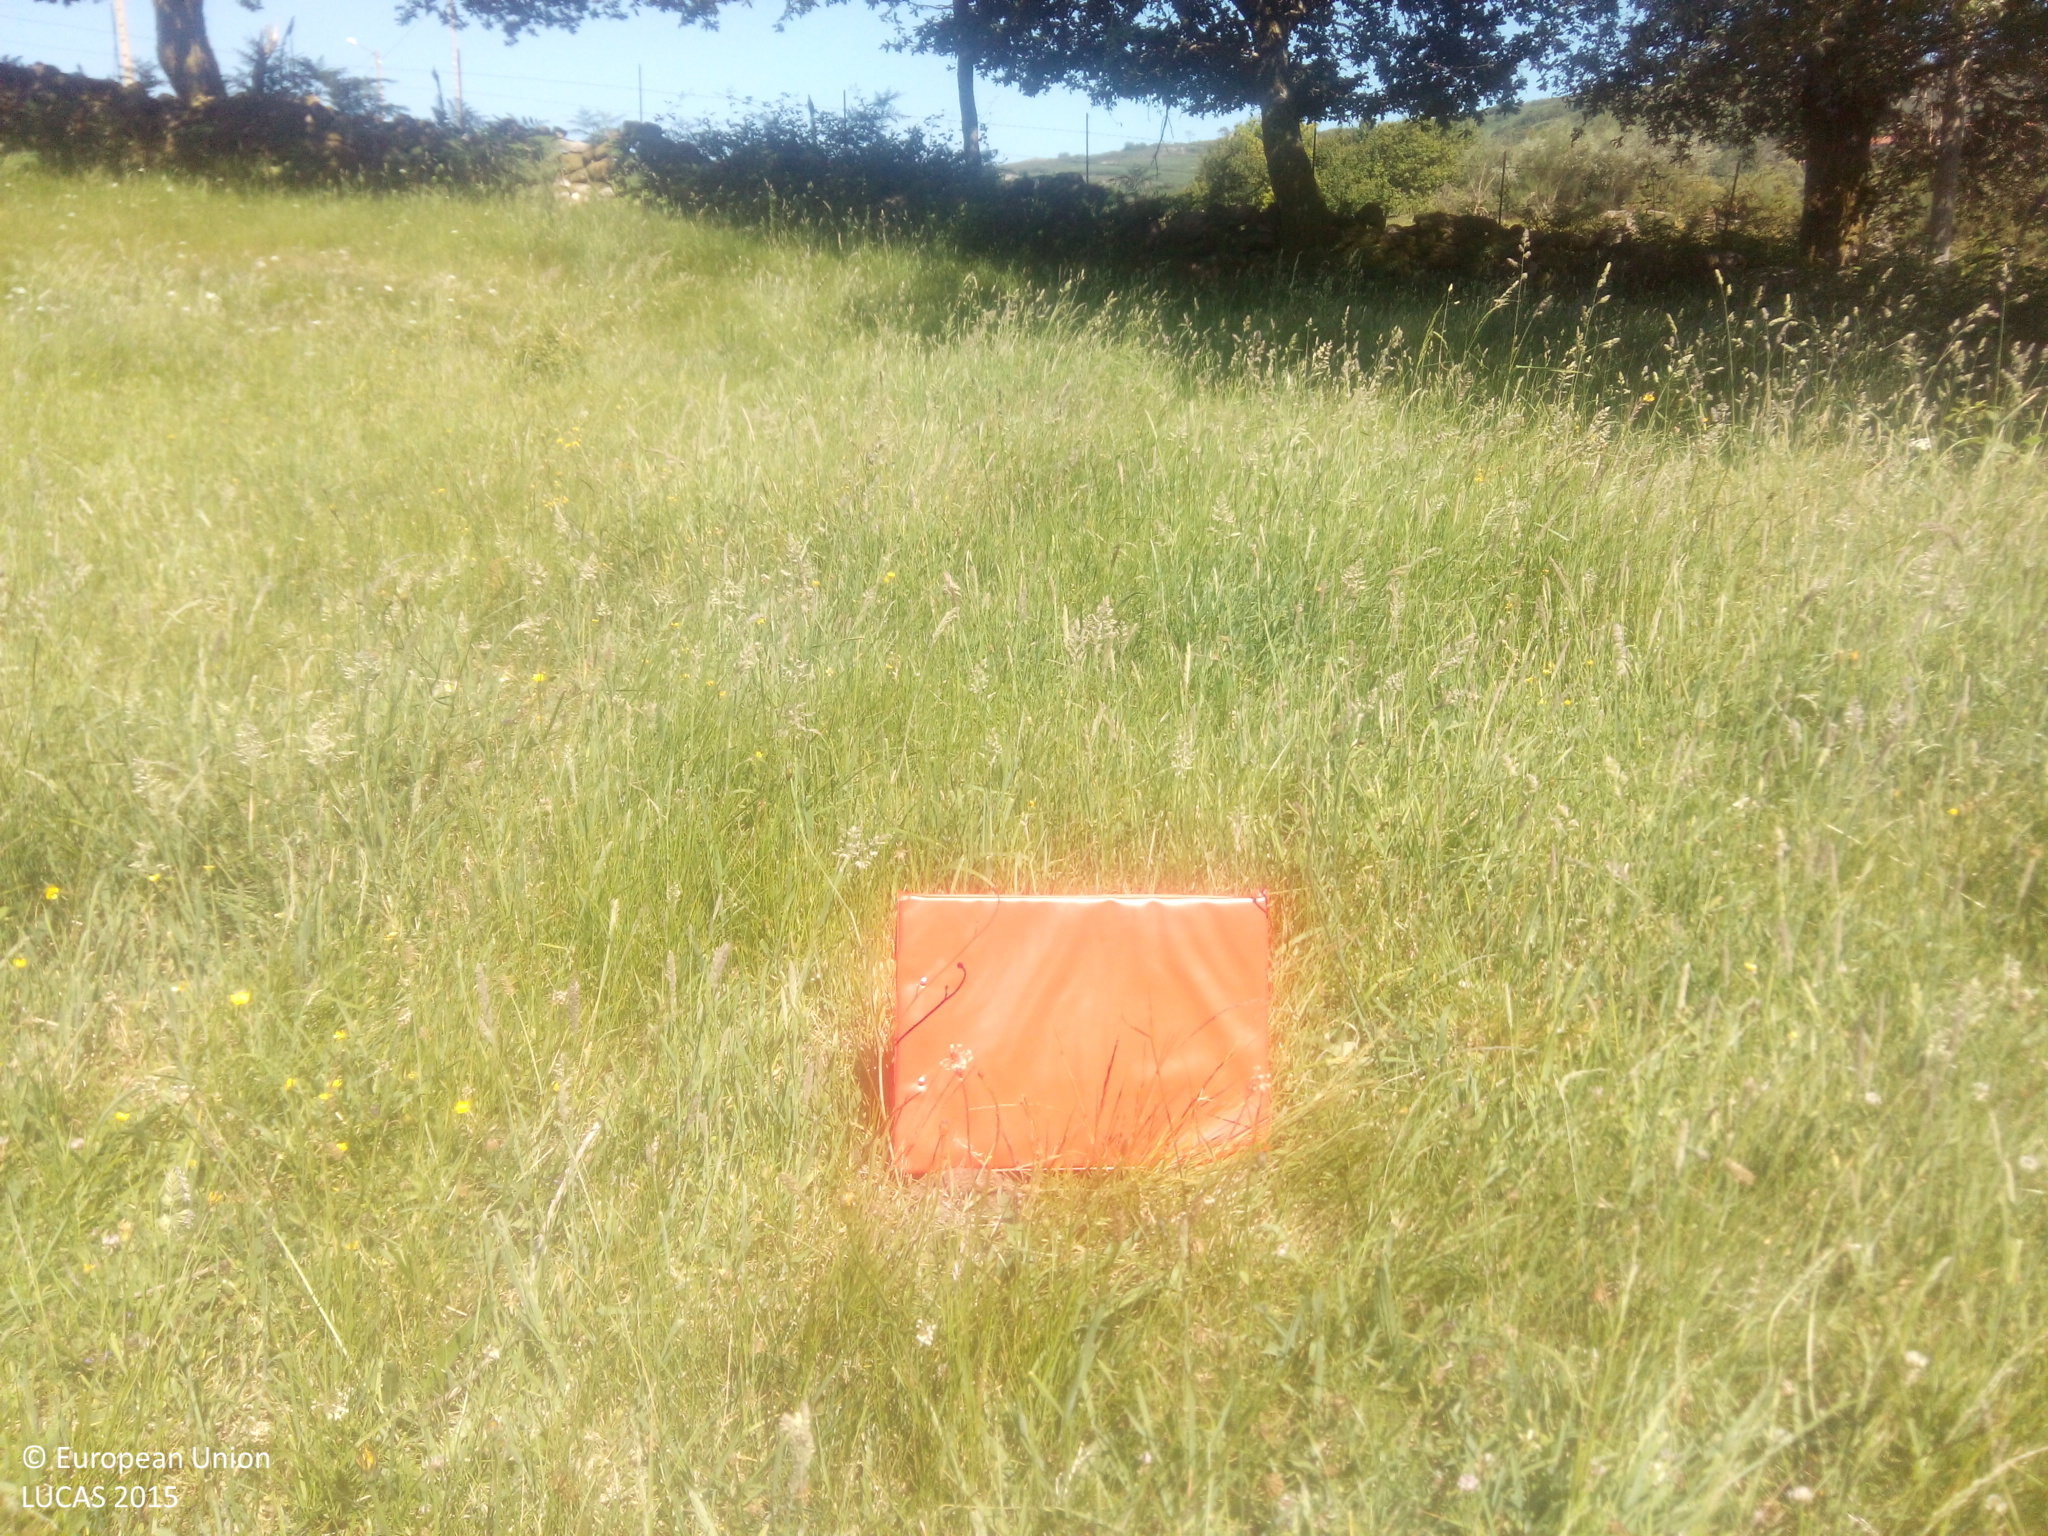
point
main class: Grassland
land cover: Grassland without tree/shrub cover
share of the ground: > 75 %
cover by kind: herbaceous plants 100 %
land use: Agriculture (excluding fallow land and kitchen gardens)
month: June
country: ES
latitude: 42.4313
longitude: -8.3874
